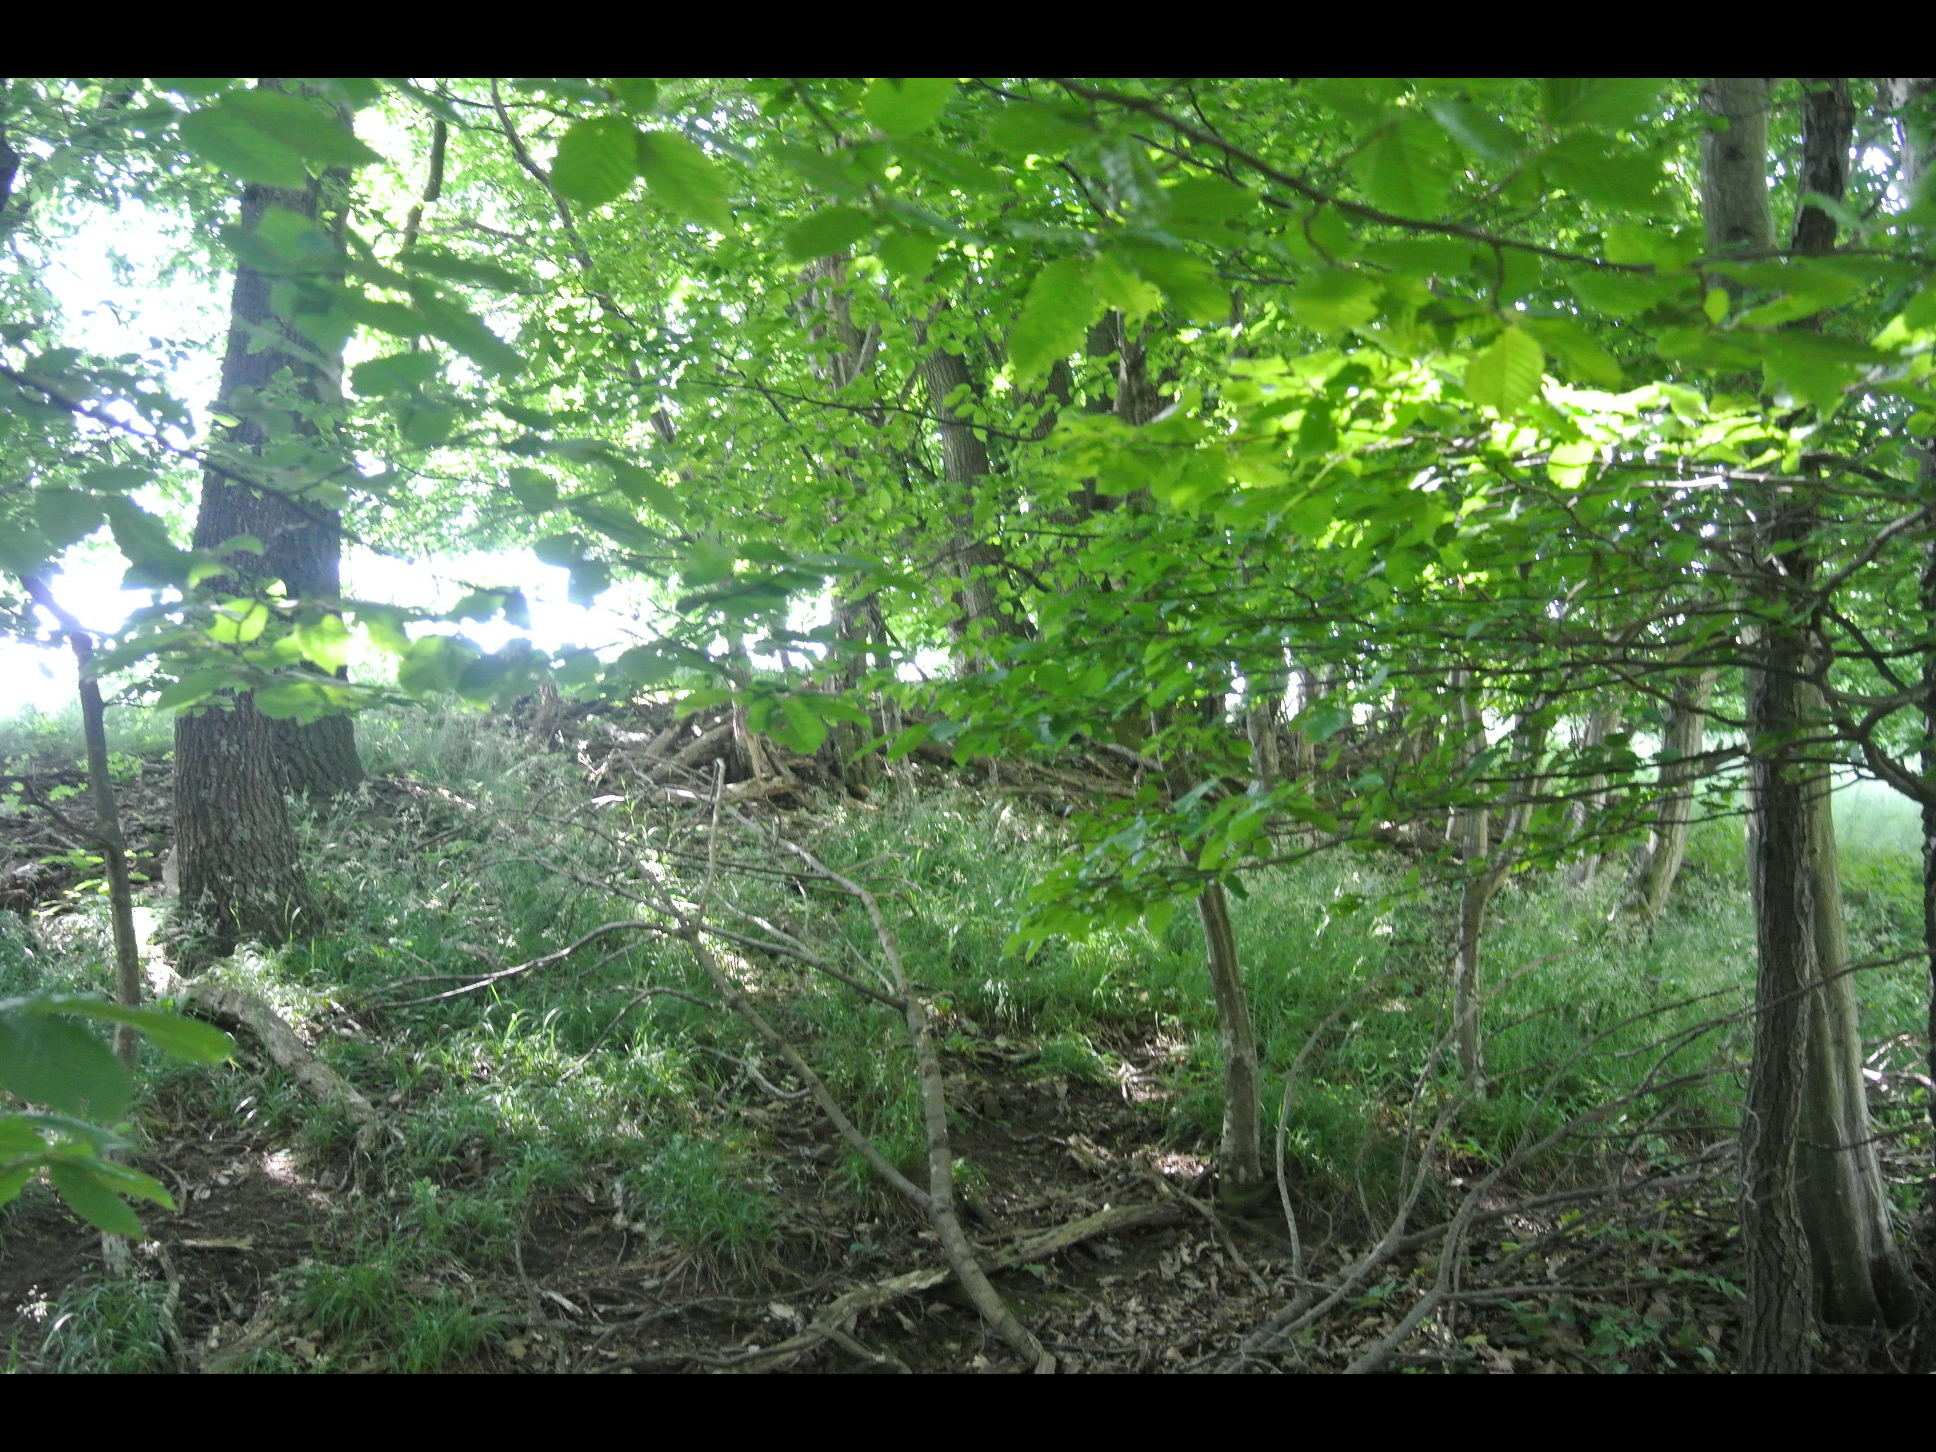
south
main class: Woodland
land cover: Broadleaved woodland
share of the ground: > 75 %
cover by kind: broadleaved forest trees 100 %
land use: Forestry
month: June
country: AT
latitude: 48.0392
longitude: 16.0527
